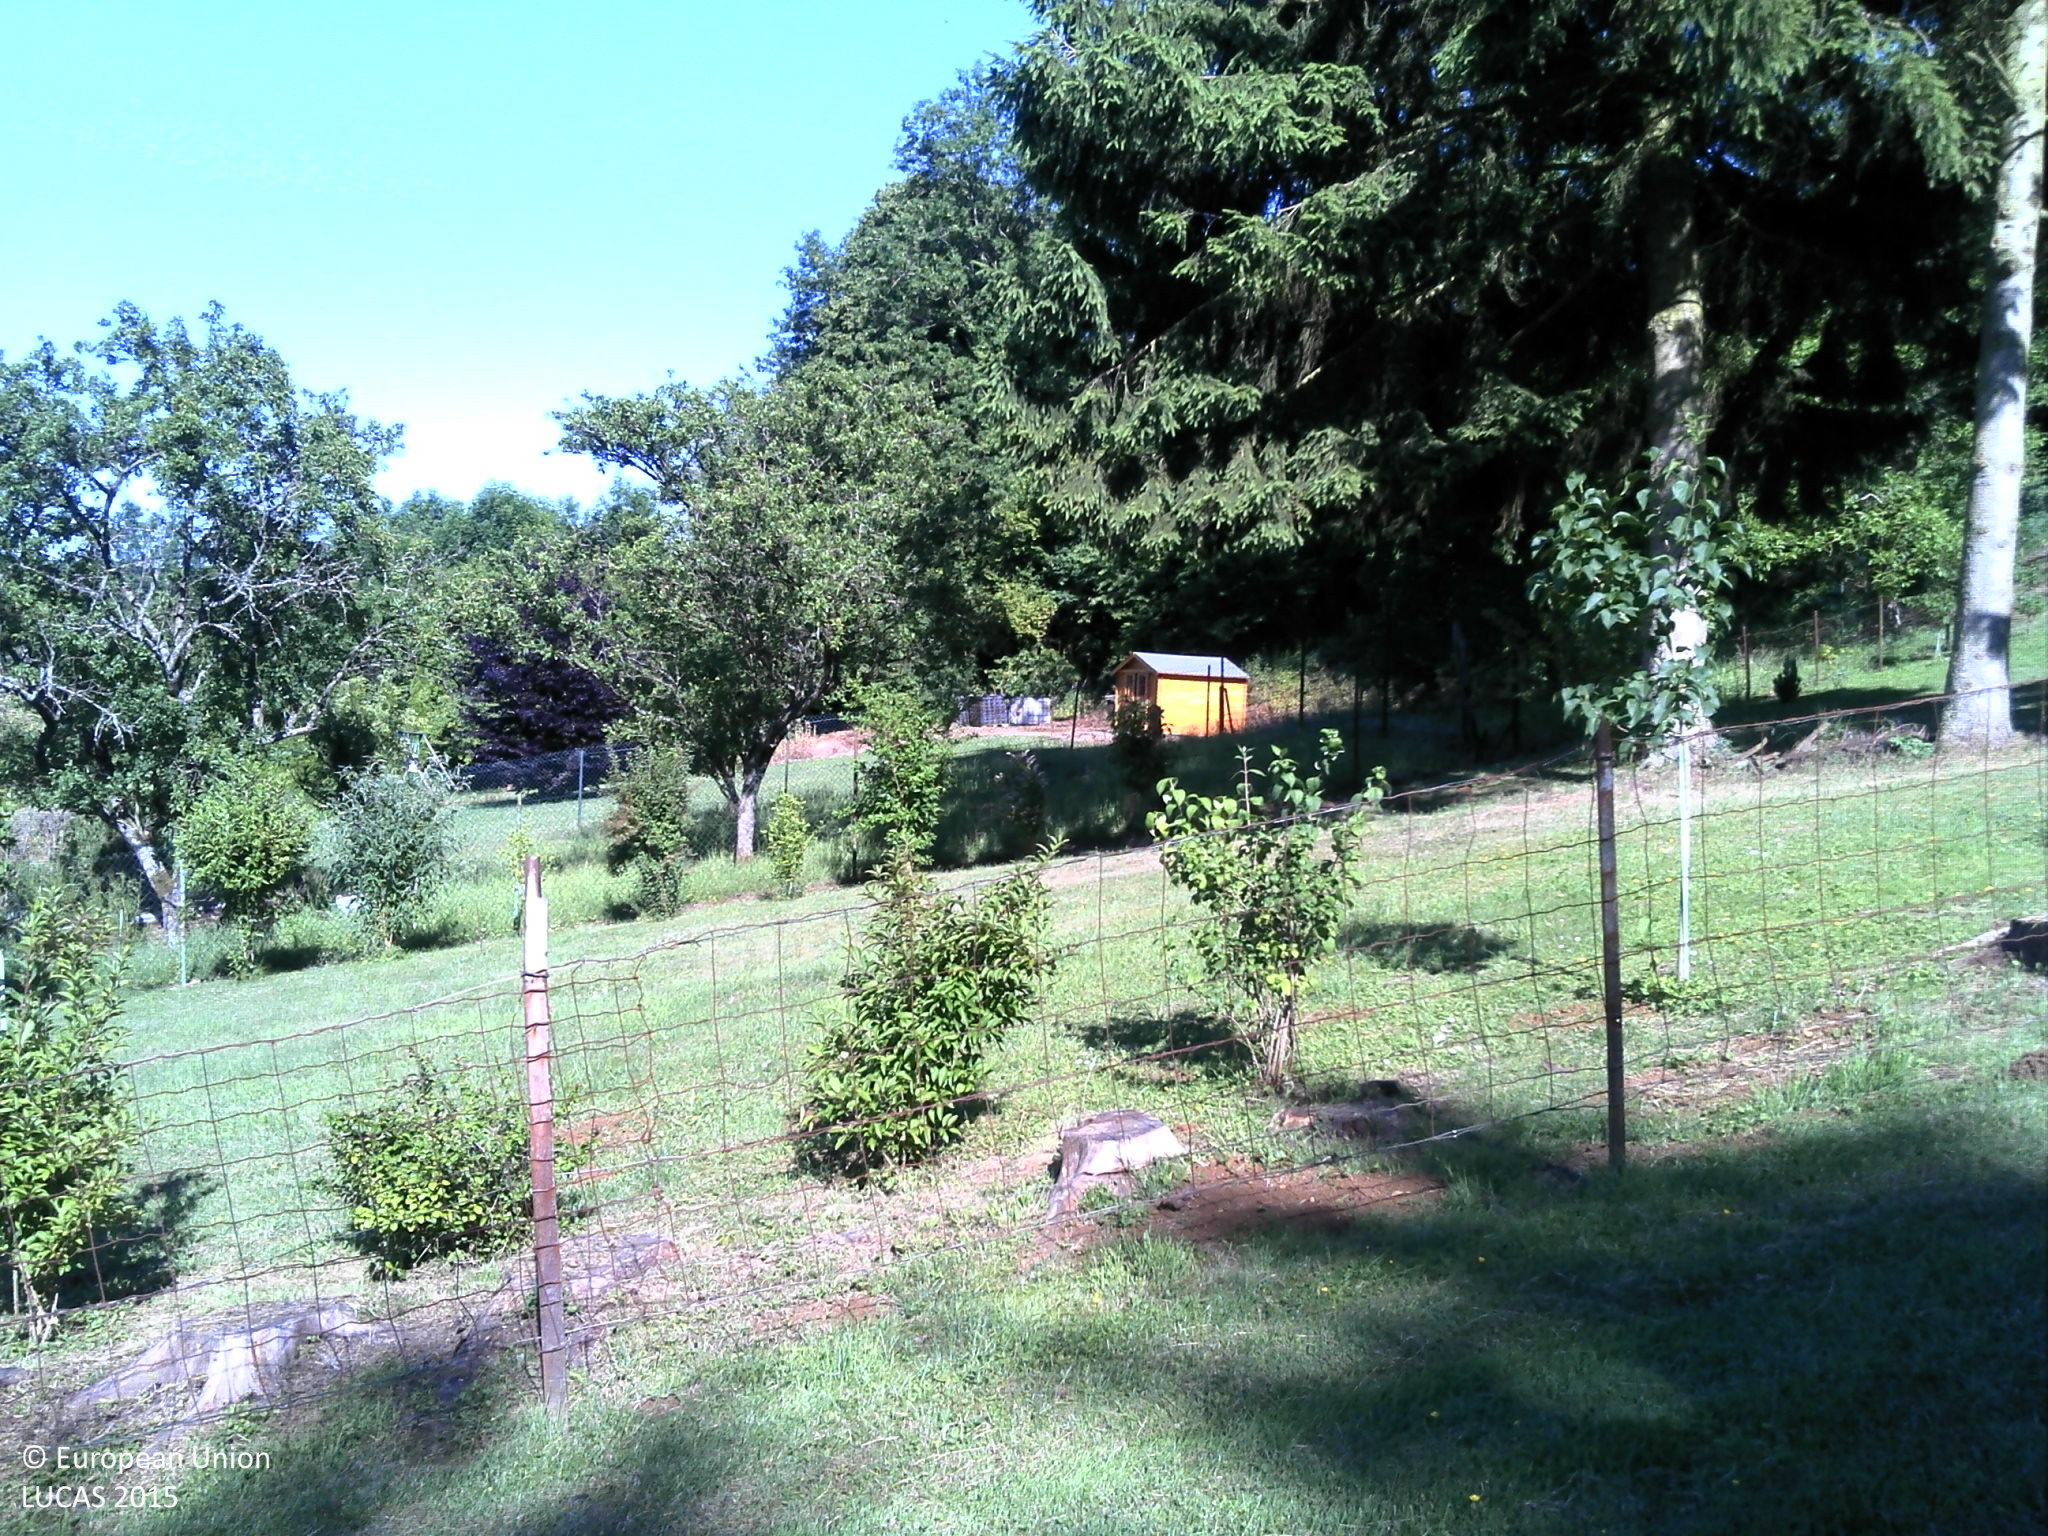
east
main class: Grassland
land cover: Grassland with sparse tree/shrub cover
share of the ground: > 75 %
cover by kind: herbaceous plants 95 %, broadleaved forest trees 5 %
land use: Residential
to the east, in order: Grassland with sparse tree/shrub cover; Fences; Artificial constructions in urban areas; Fences; Broadleaved woodland; Artificial constructions in urban areas
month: June
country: FR
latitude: 49.4144
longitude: 6.0710
